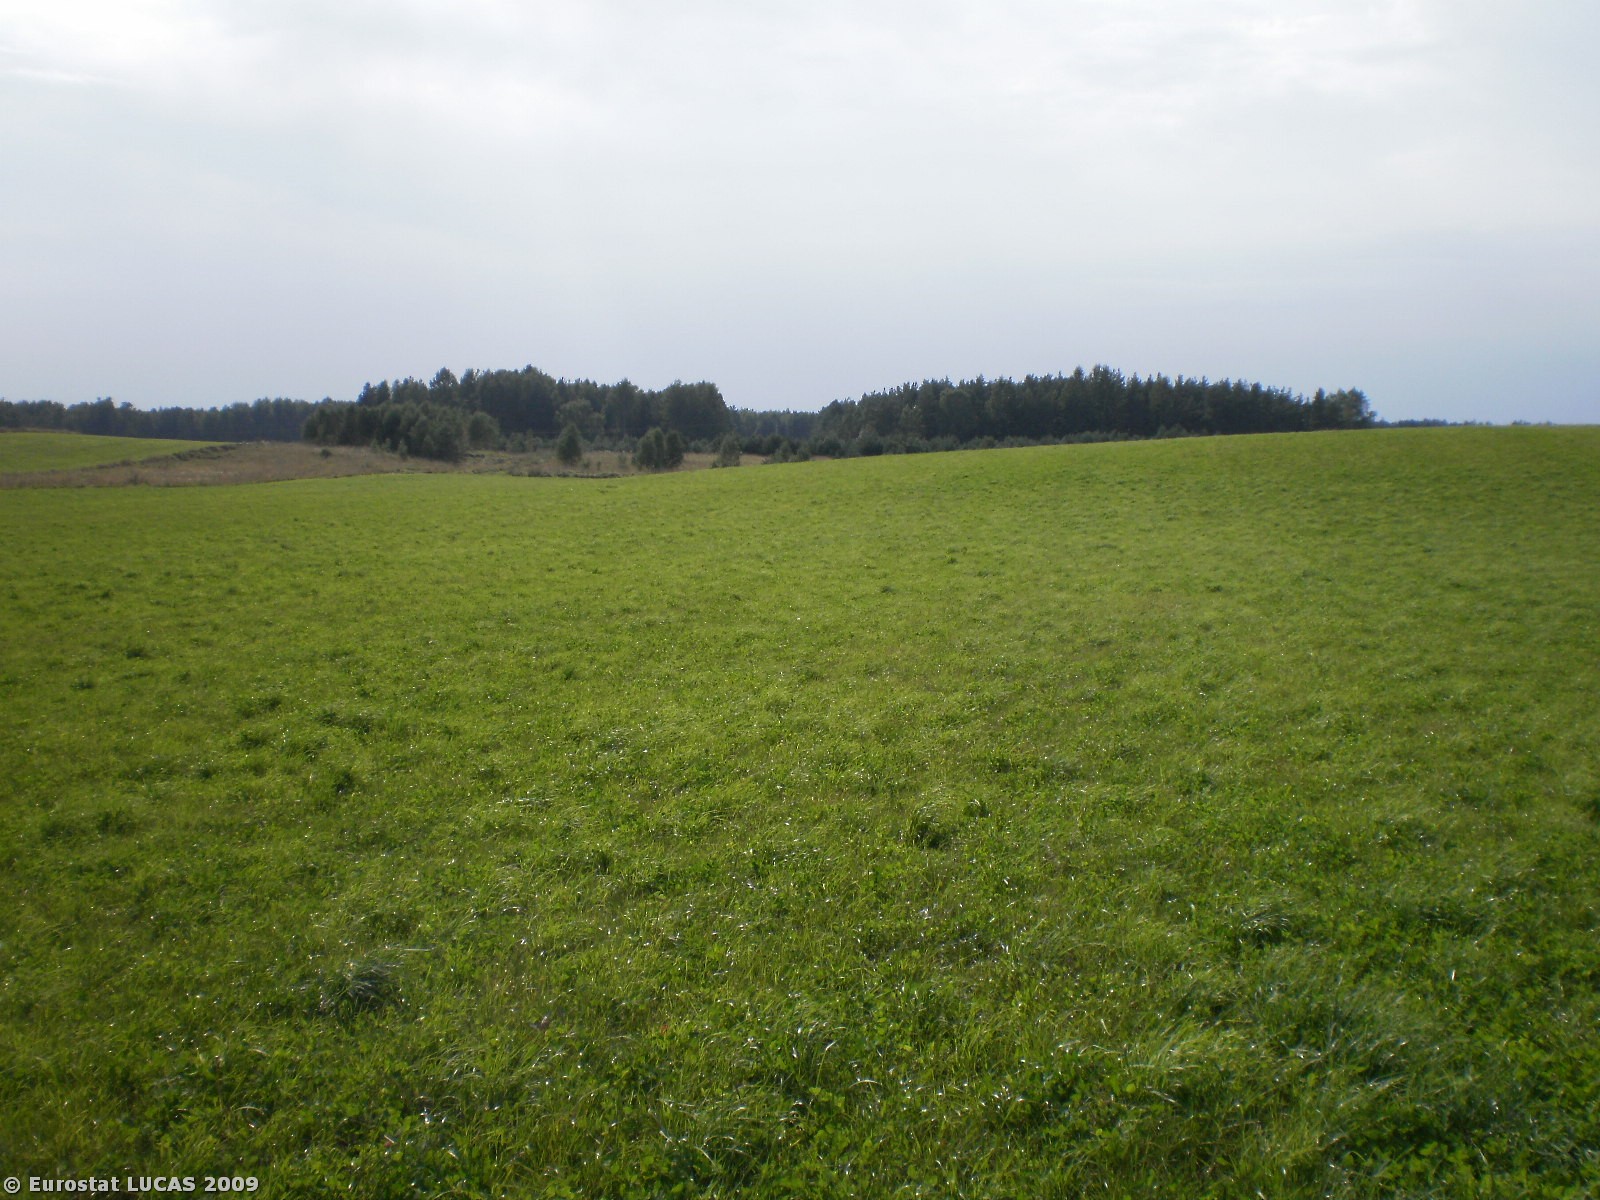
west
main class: Grassland
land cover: Grassland without tree/shrub cover
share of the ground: > 75 %
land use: Agriculture (excluding fallow land and kitchen gardens)
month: September
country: PL
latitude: 53.6725
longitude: 21.0790
